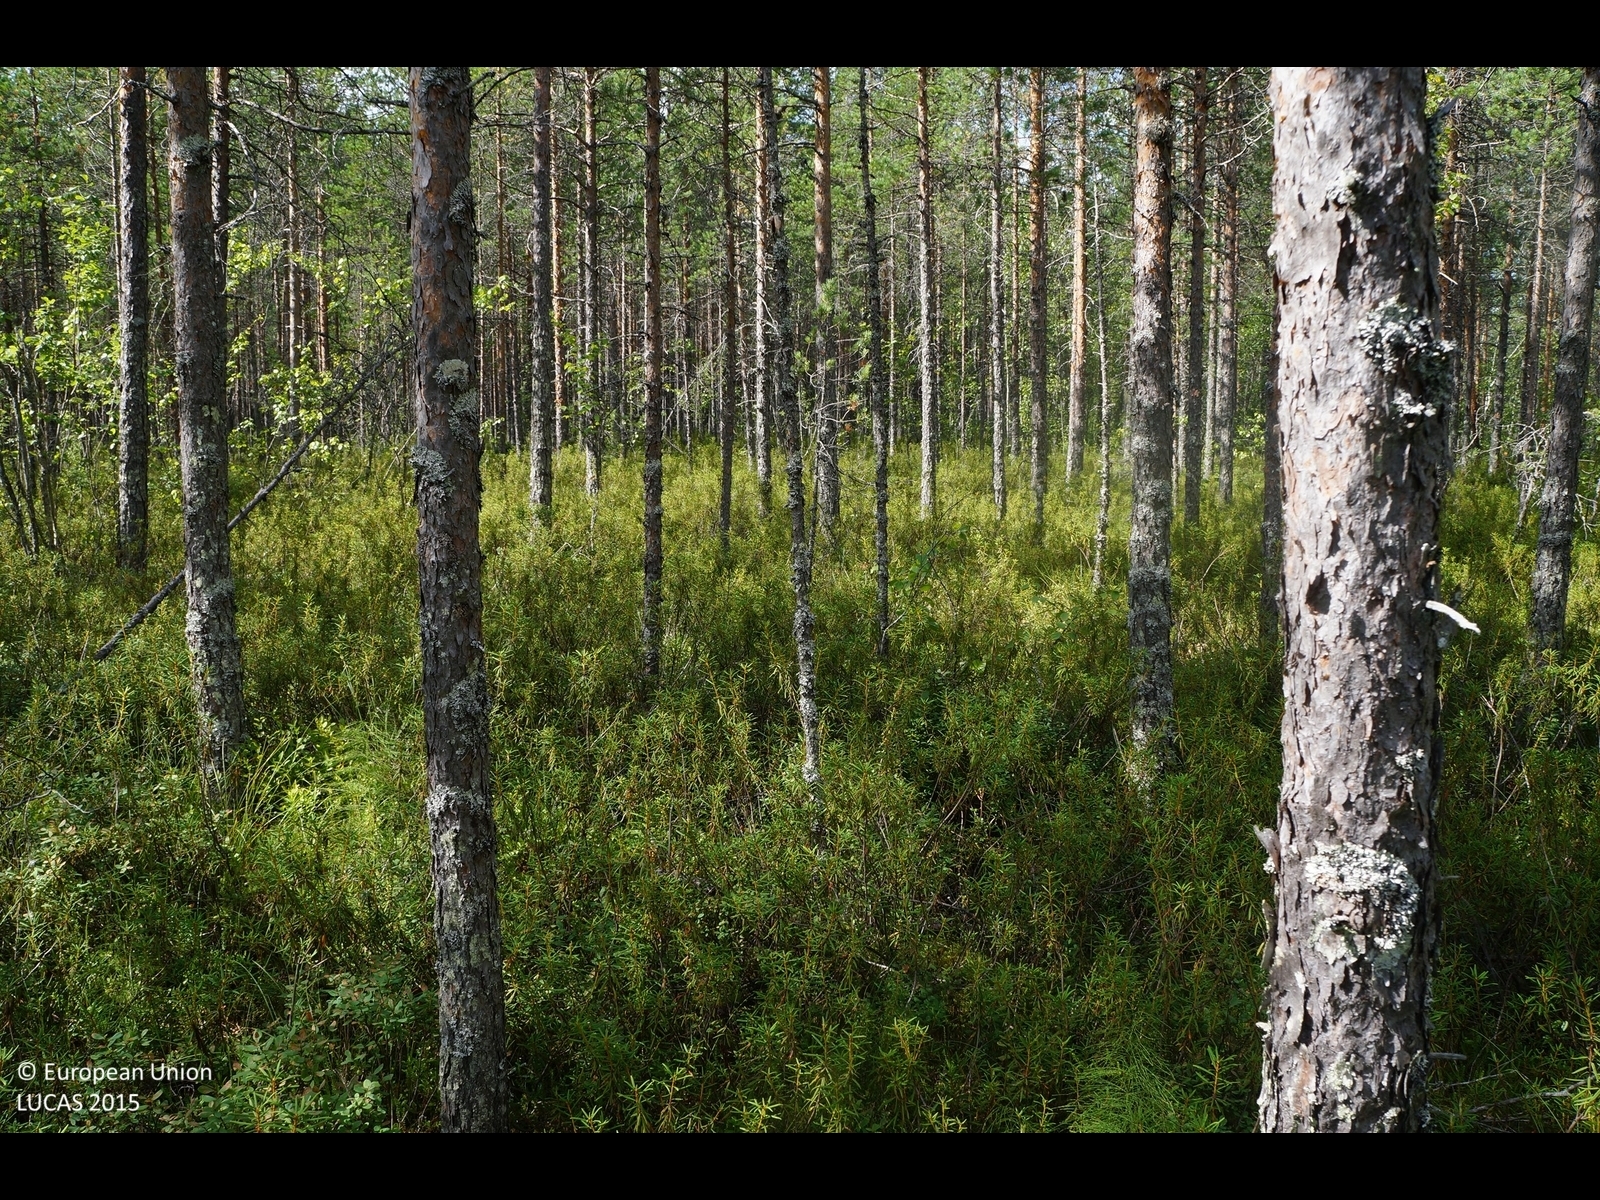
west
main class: Woodland
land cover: Pine dominated coniferous woodland
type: boreal forest
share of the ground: 25 - 50 %
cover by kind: coniferous forest trees 40 %, shrubs 40 %, lichens and mosses 15 %, broadleaved forest trees 5 %
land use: Forestry
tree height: > 5 m
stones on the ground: < 10 %
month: August
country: FI
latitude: 64.4446
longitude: 26.0389
